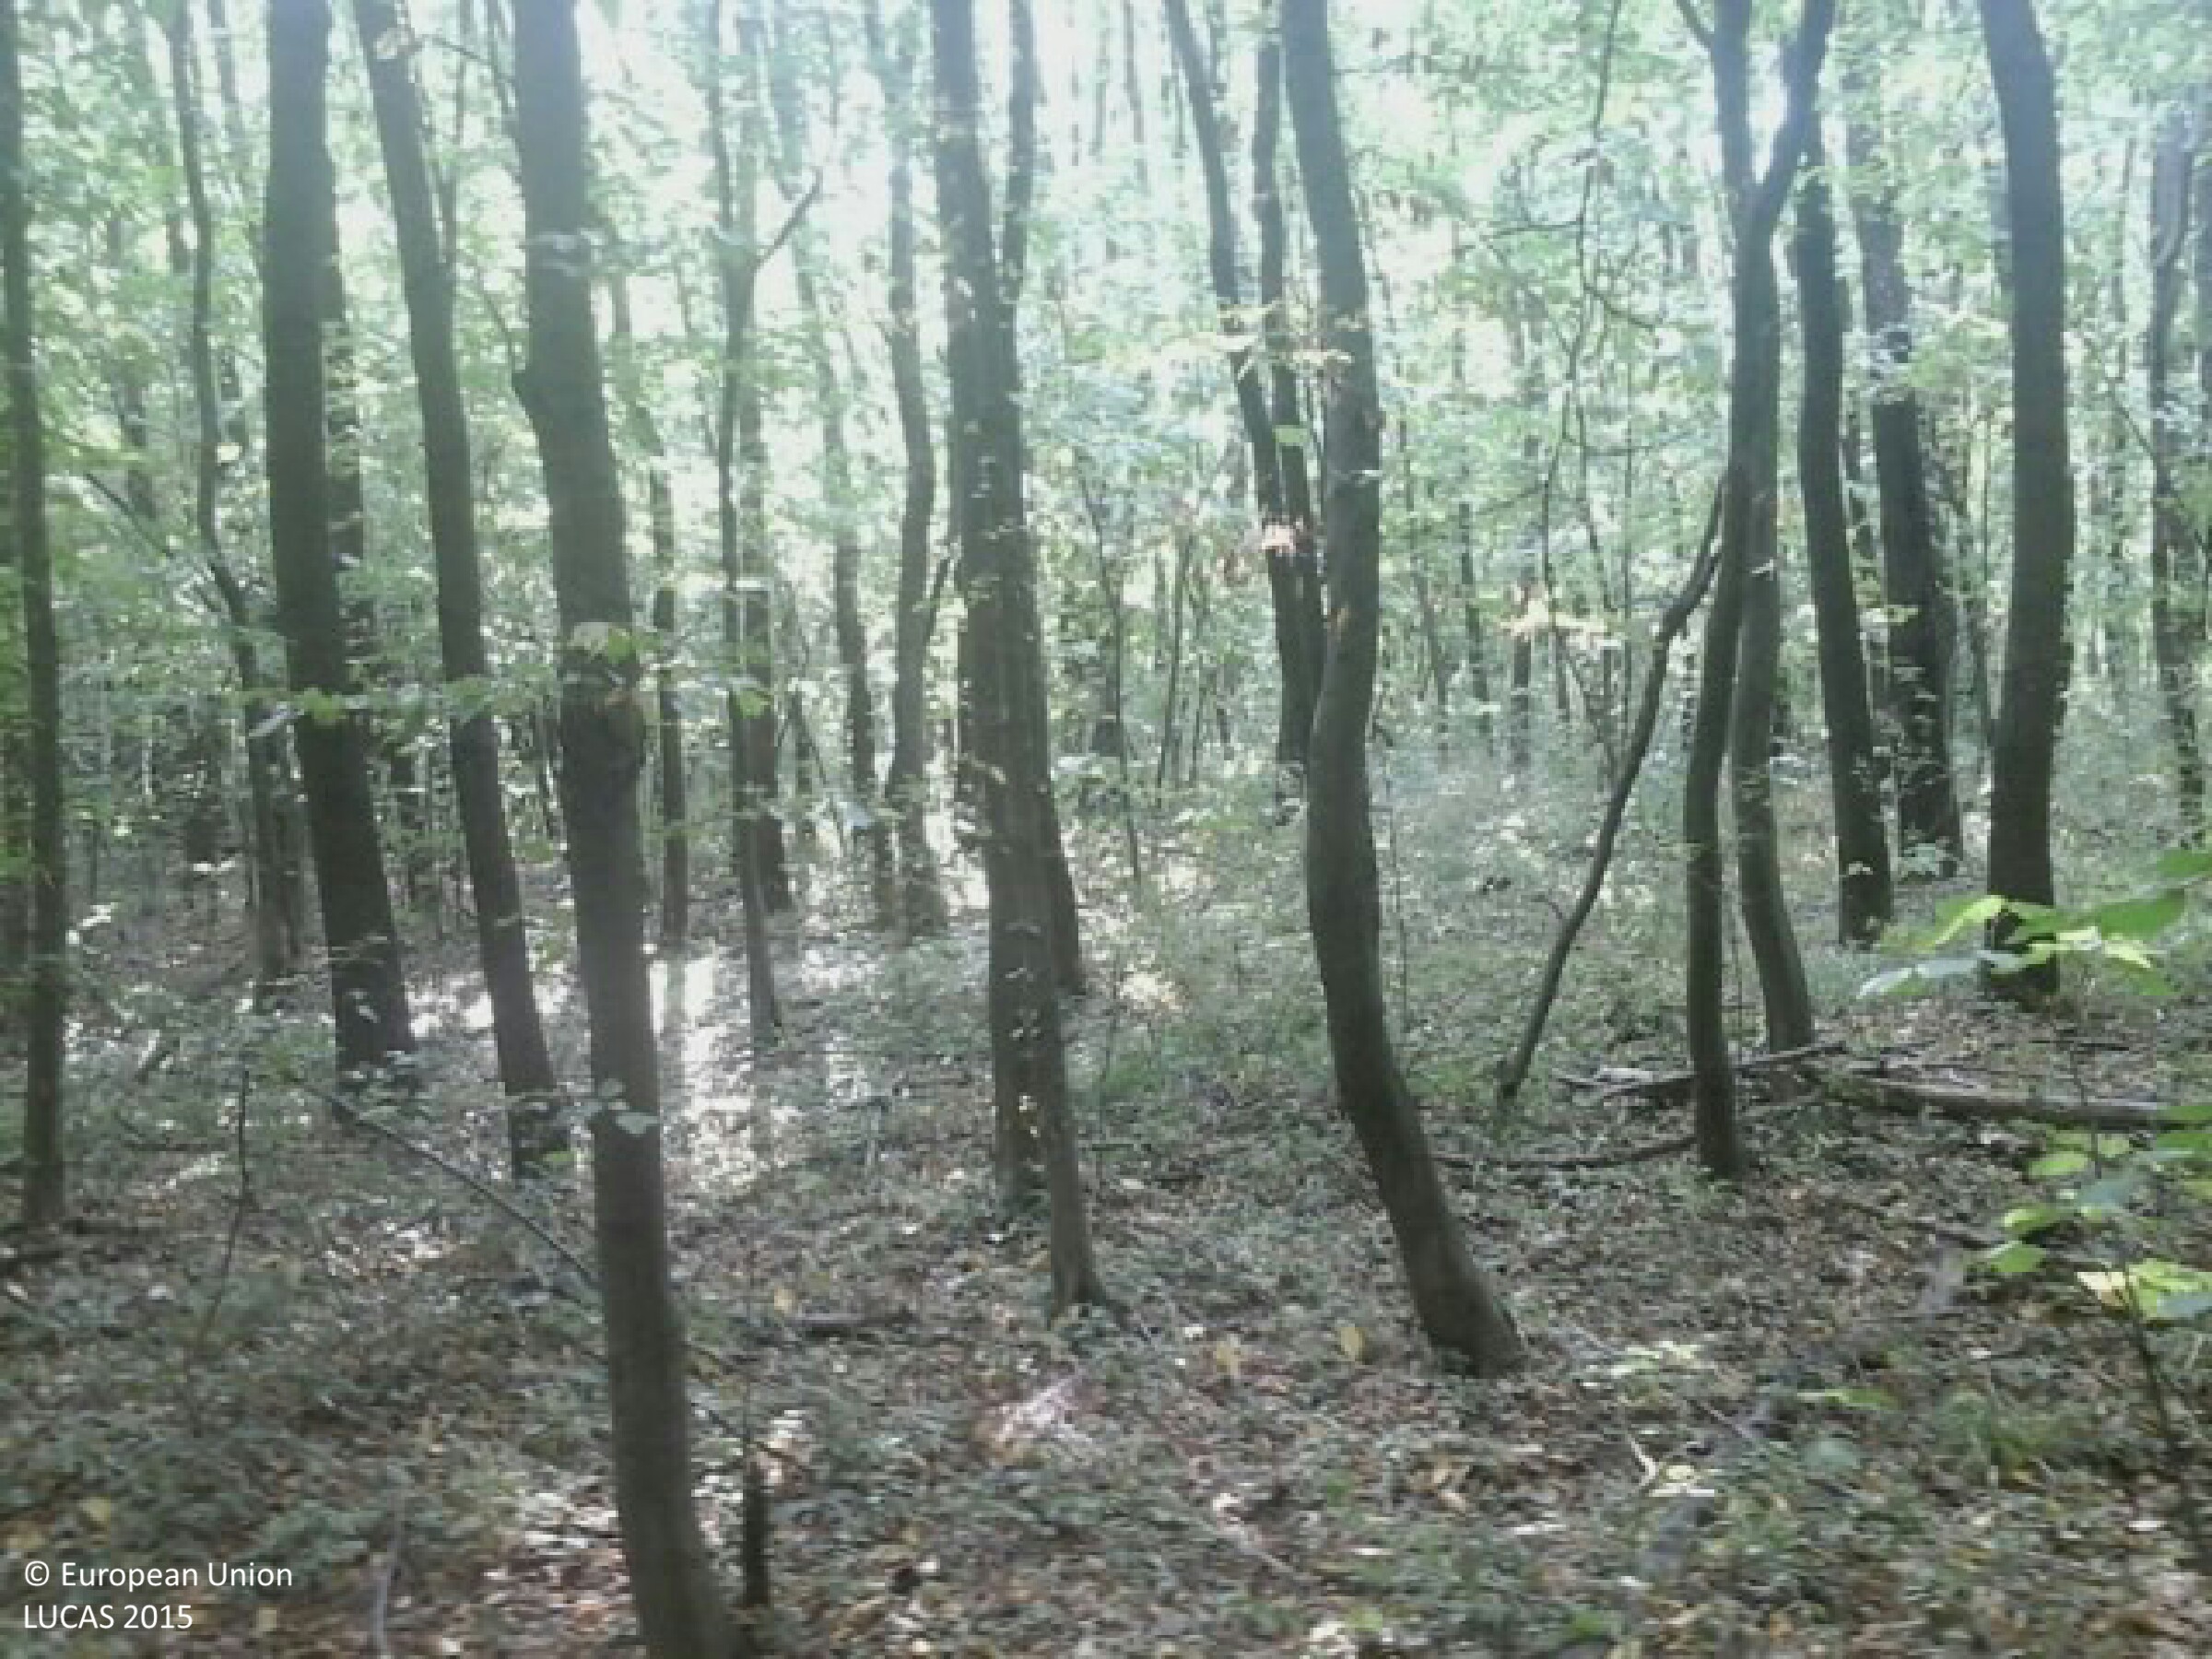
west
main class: Woodland
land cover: Broadleaved woodland
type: mesophytic deciduous forest
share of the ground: > 75 %
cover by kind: broadleaved forest trees 95 %, herbaceous plants 5 %
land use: Forestry
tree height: > 5 m
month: August
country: HU
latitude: 46.2319
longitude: 18.2416
